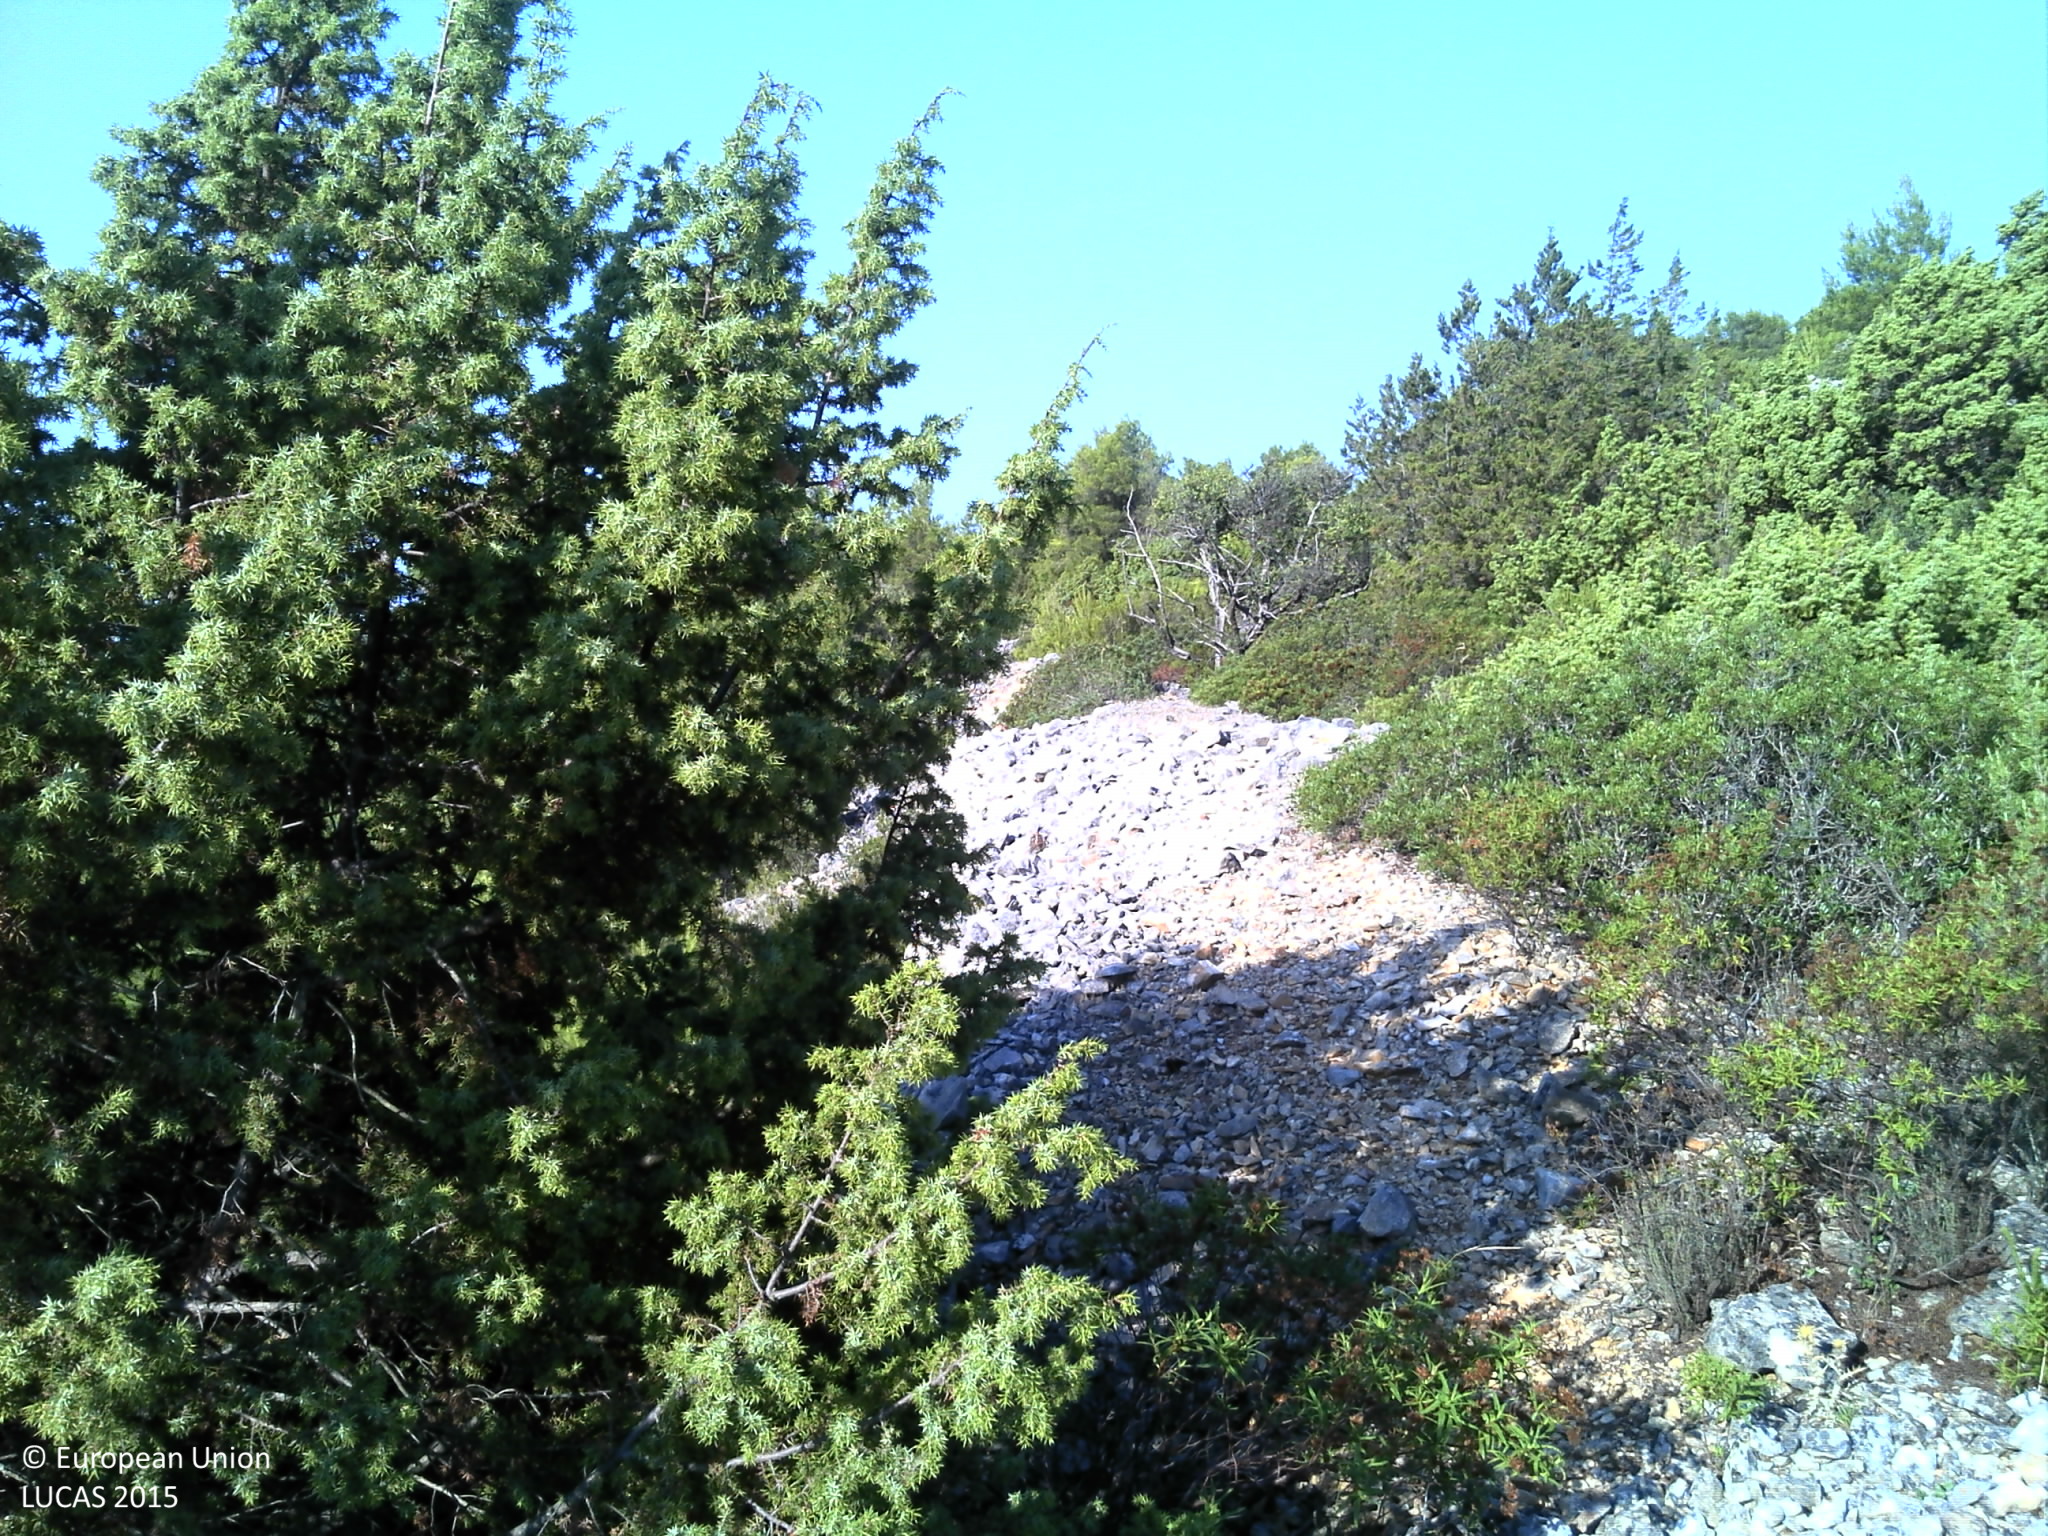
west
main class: Shrubland
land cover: Shrubland with sparse tree cover
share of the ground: > 75 %
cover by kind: shrubs 60 %, unconsolidated bare surface 20 %, herbaceous plants 10 %, coniferous forest trees 5 %, consolidated bare surface 5 %
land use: Abandoned areas
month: August
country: HR
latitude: 43.0456
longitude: 16.1633
